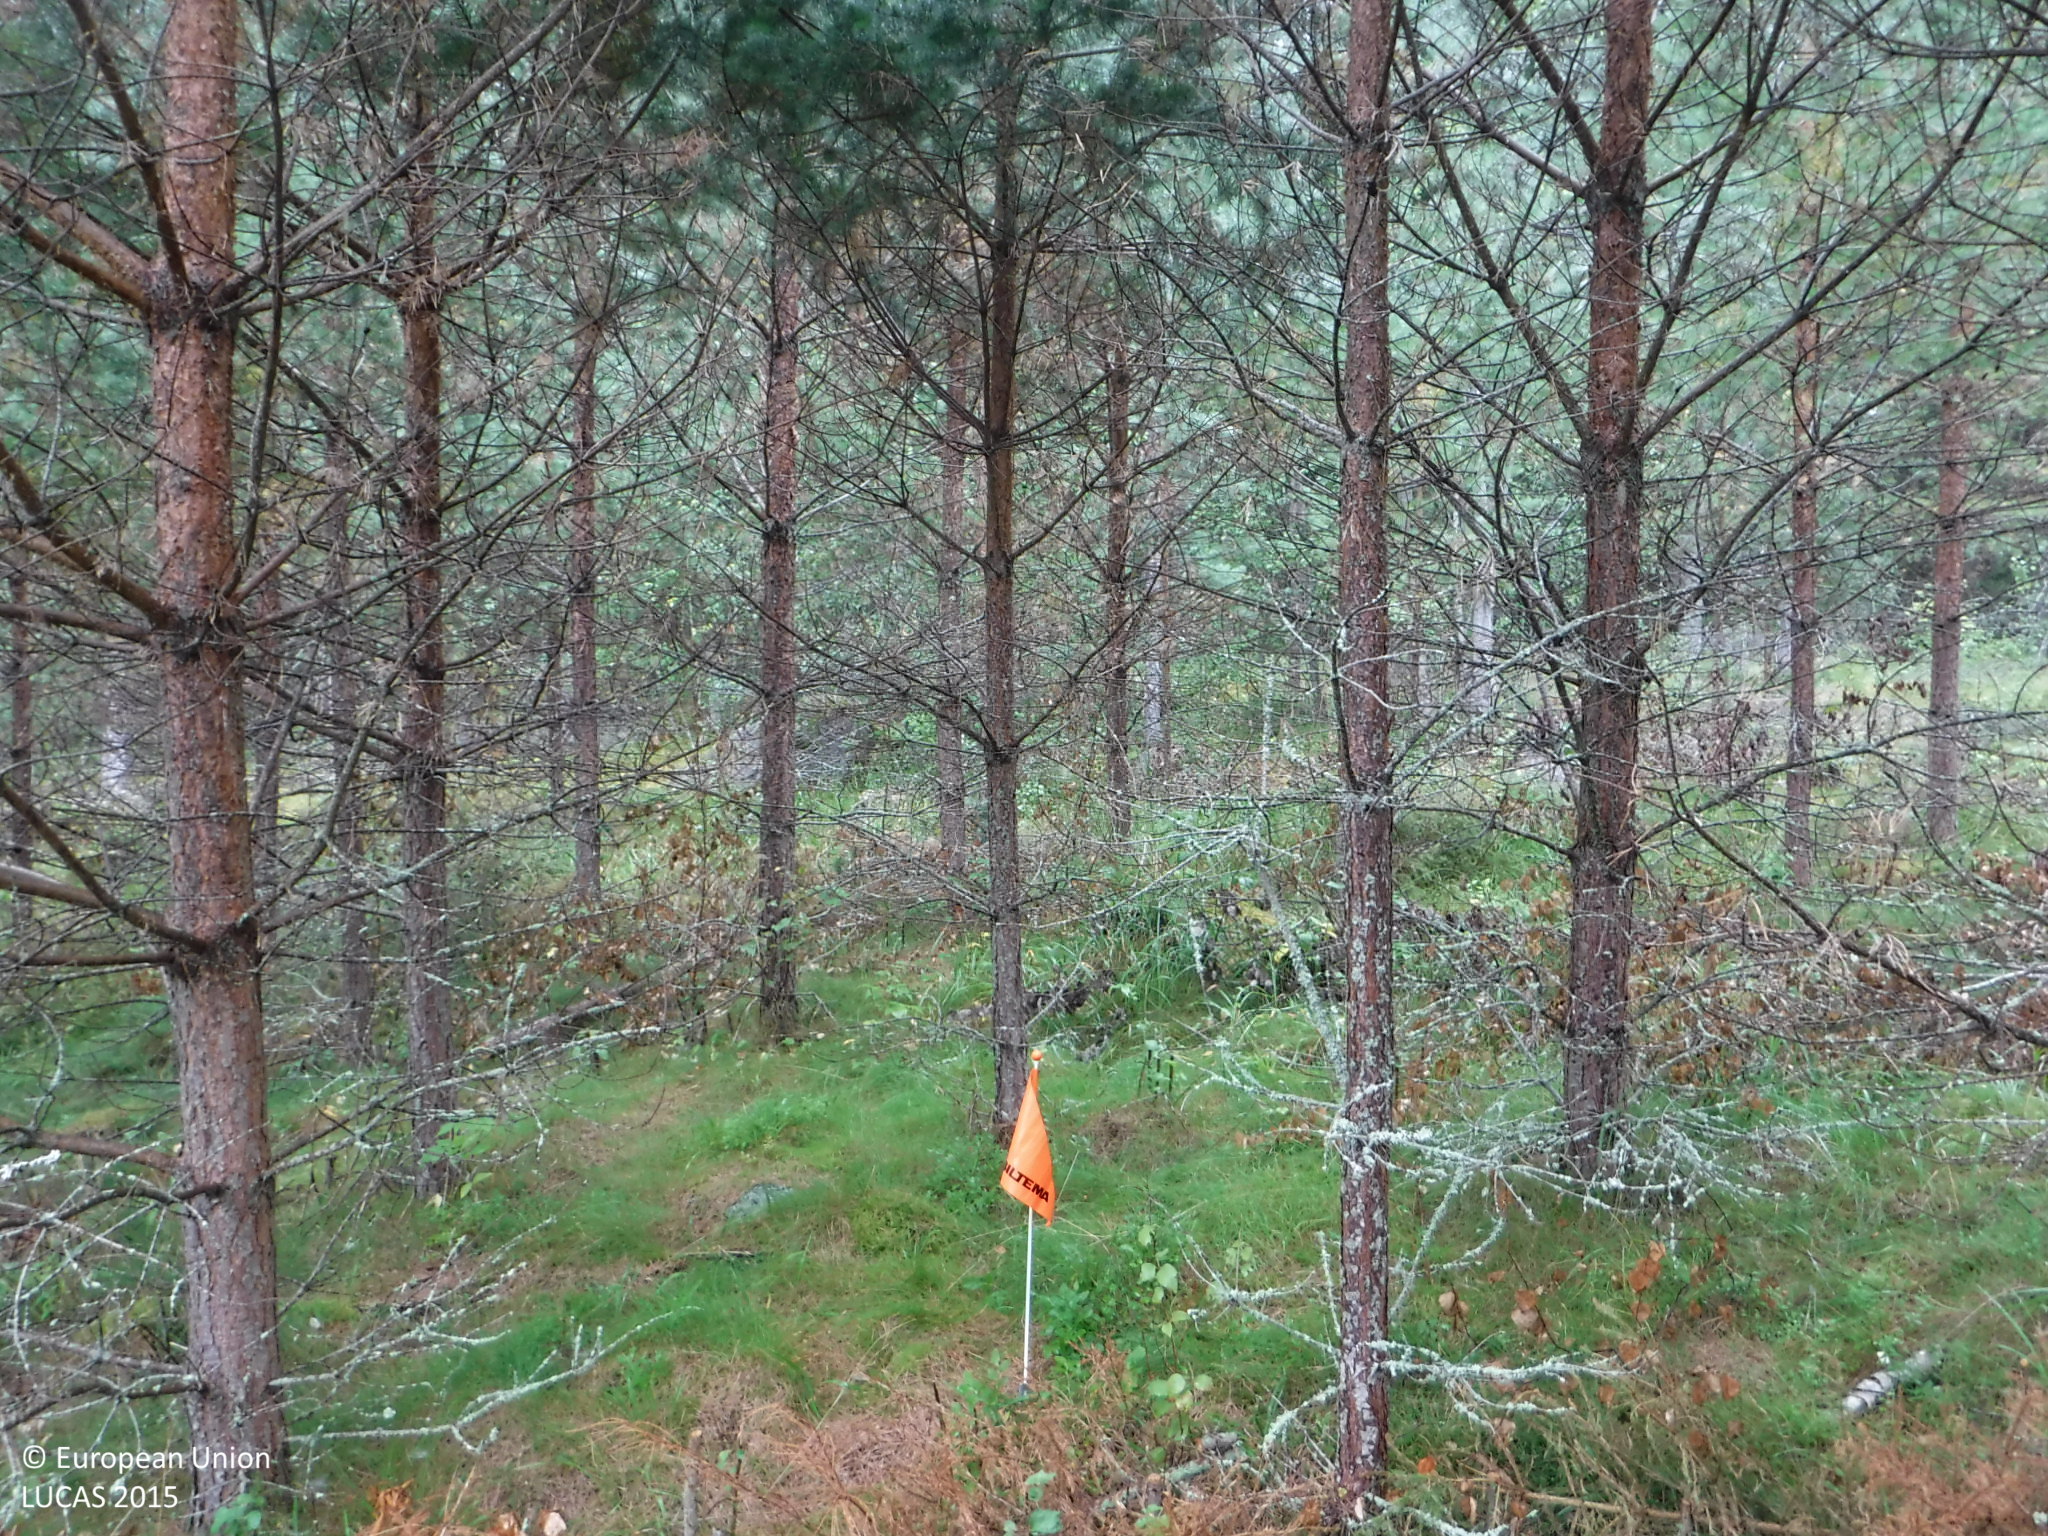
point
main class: Woodland
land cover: Pine dominated coniferous woodland
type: boreal forest
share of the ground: 50 - 75 %
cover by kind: coniferous forest trees 65 %, herbaceous plants 25 %, broadleaved forest trees 5 %, shrubs 5 %
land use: Forestry
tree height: > 5 m
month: August
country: FI
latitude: 61.2337
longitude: 22.8682
